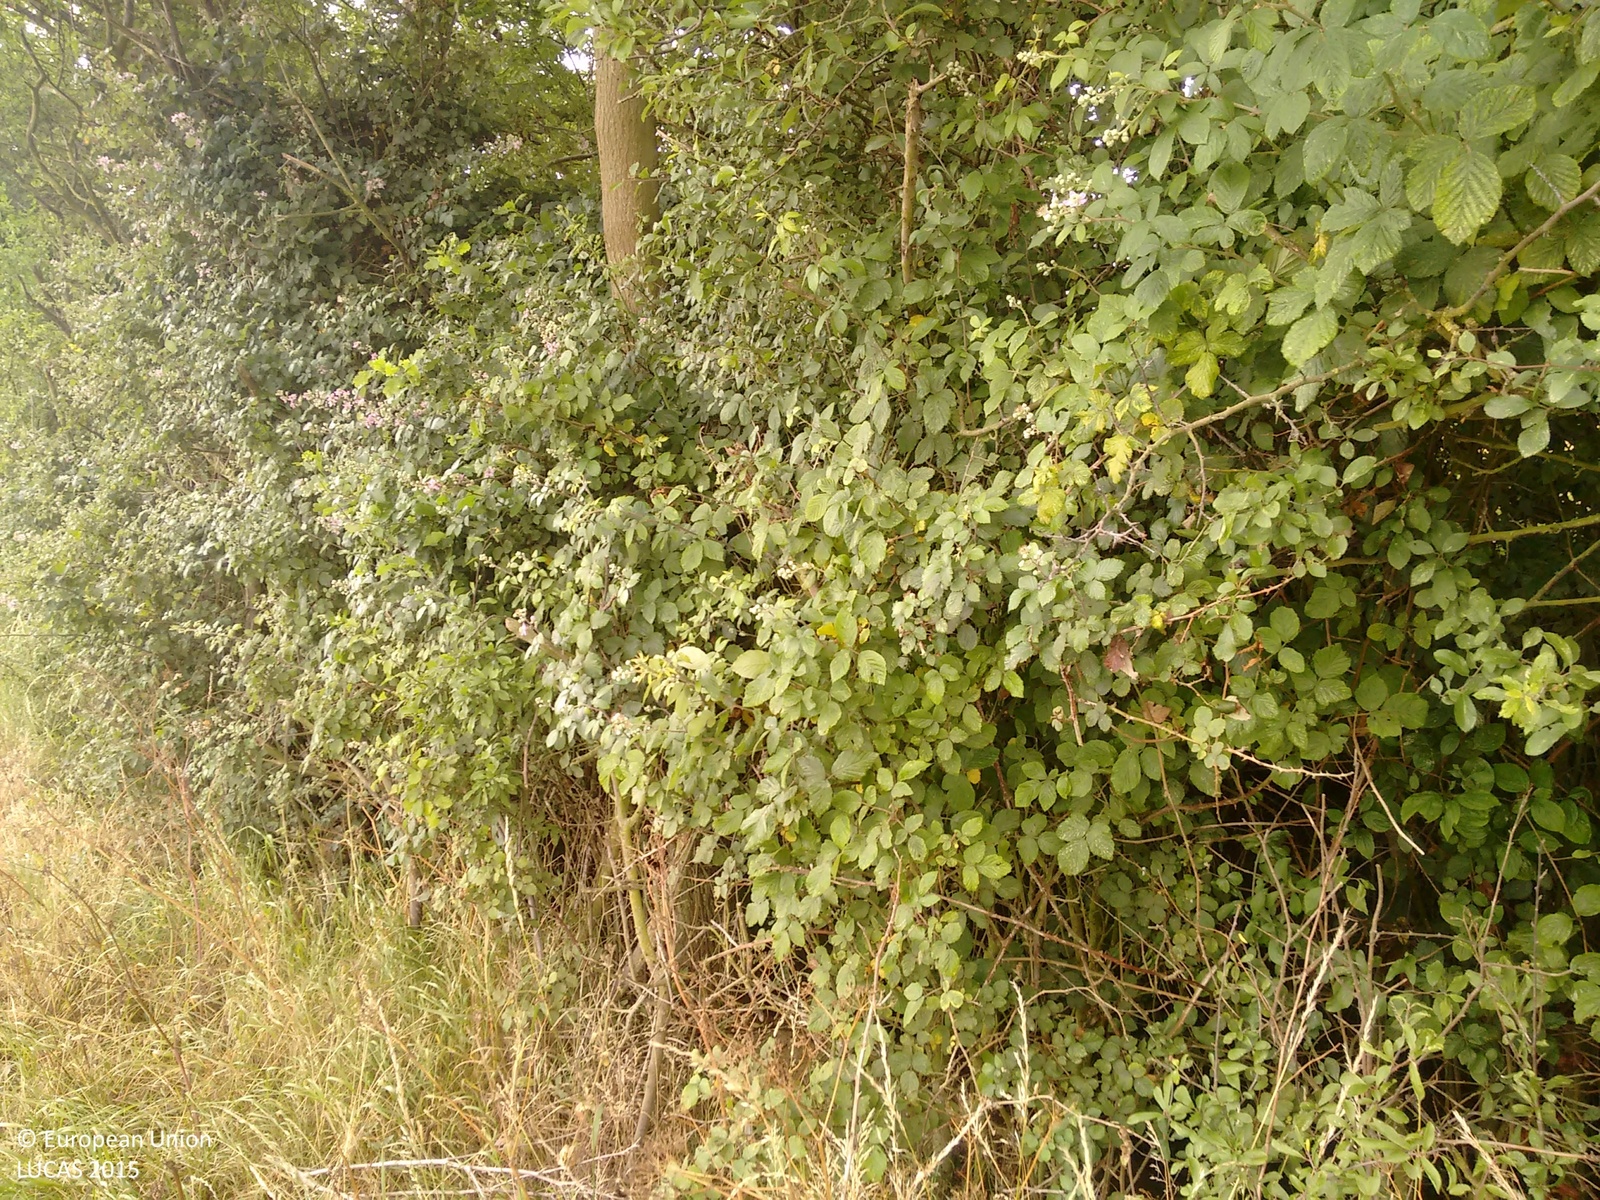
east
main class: Cropland
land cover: Common wheat
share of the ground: > 75 %
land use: Agriculture (excluding fallow land and kitchen gardens)
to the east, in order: Managed hedges; Ditches and canals; Grass margins; Common wheat; Tracks; Grass margins; Broadleaved woodland; Tracks; Grassland without tree/shrub cover; Inland fresh water bodies
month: July
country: GB
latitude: 51.6390
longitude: 0.5661
